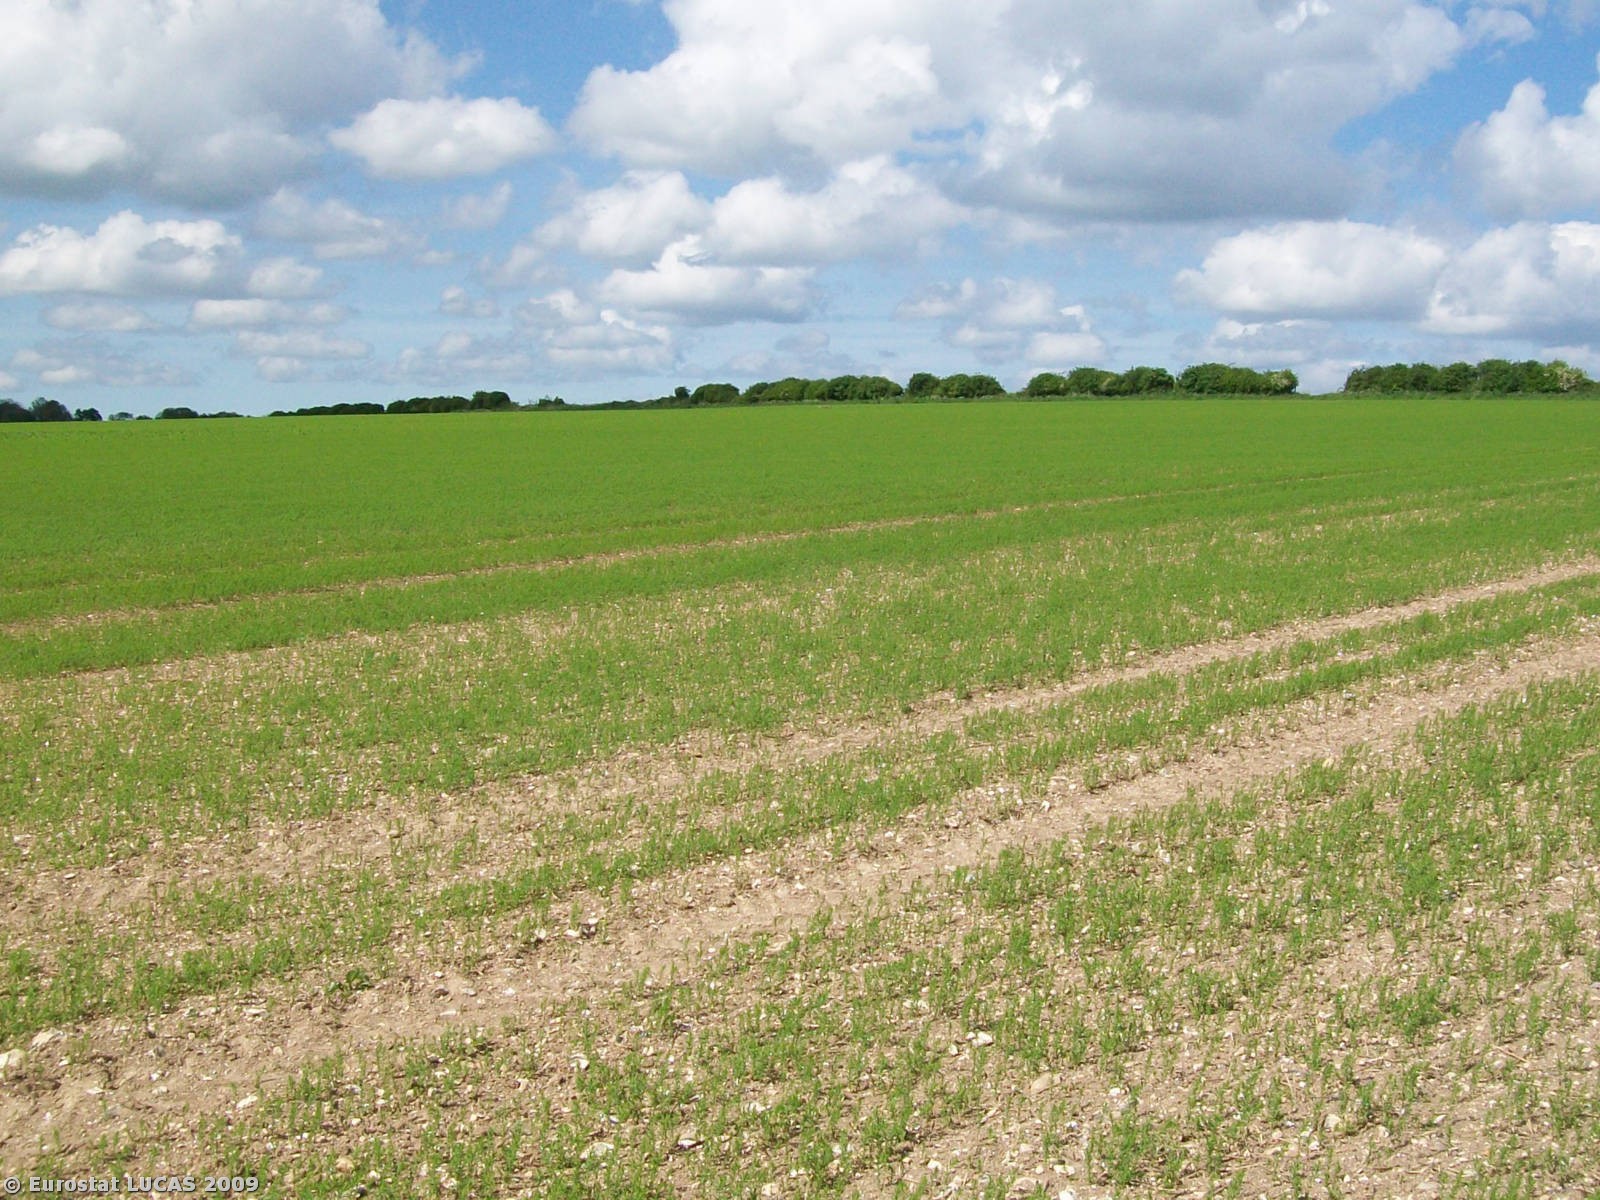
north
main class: Cropland
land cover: Other fibre and oleaginous crops
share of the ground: 50 - 75 %
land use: Agriculture (excluding fallow land and kitchen gardens)
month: May
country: GB
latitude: 50.9183
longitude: -2.1082
